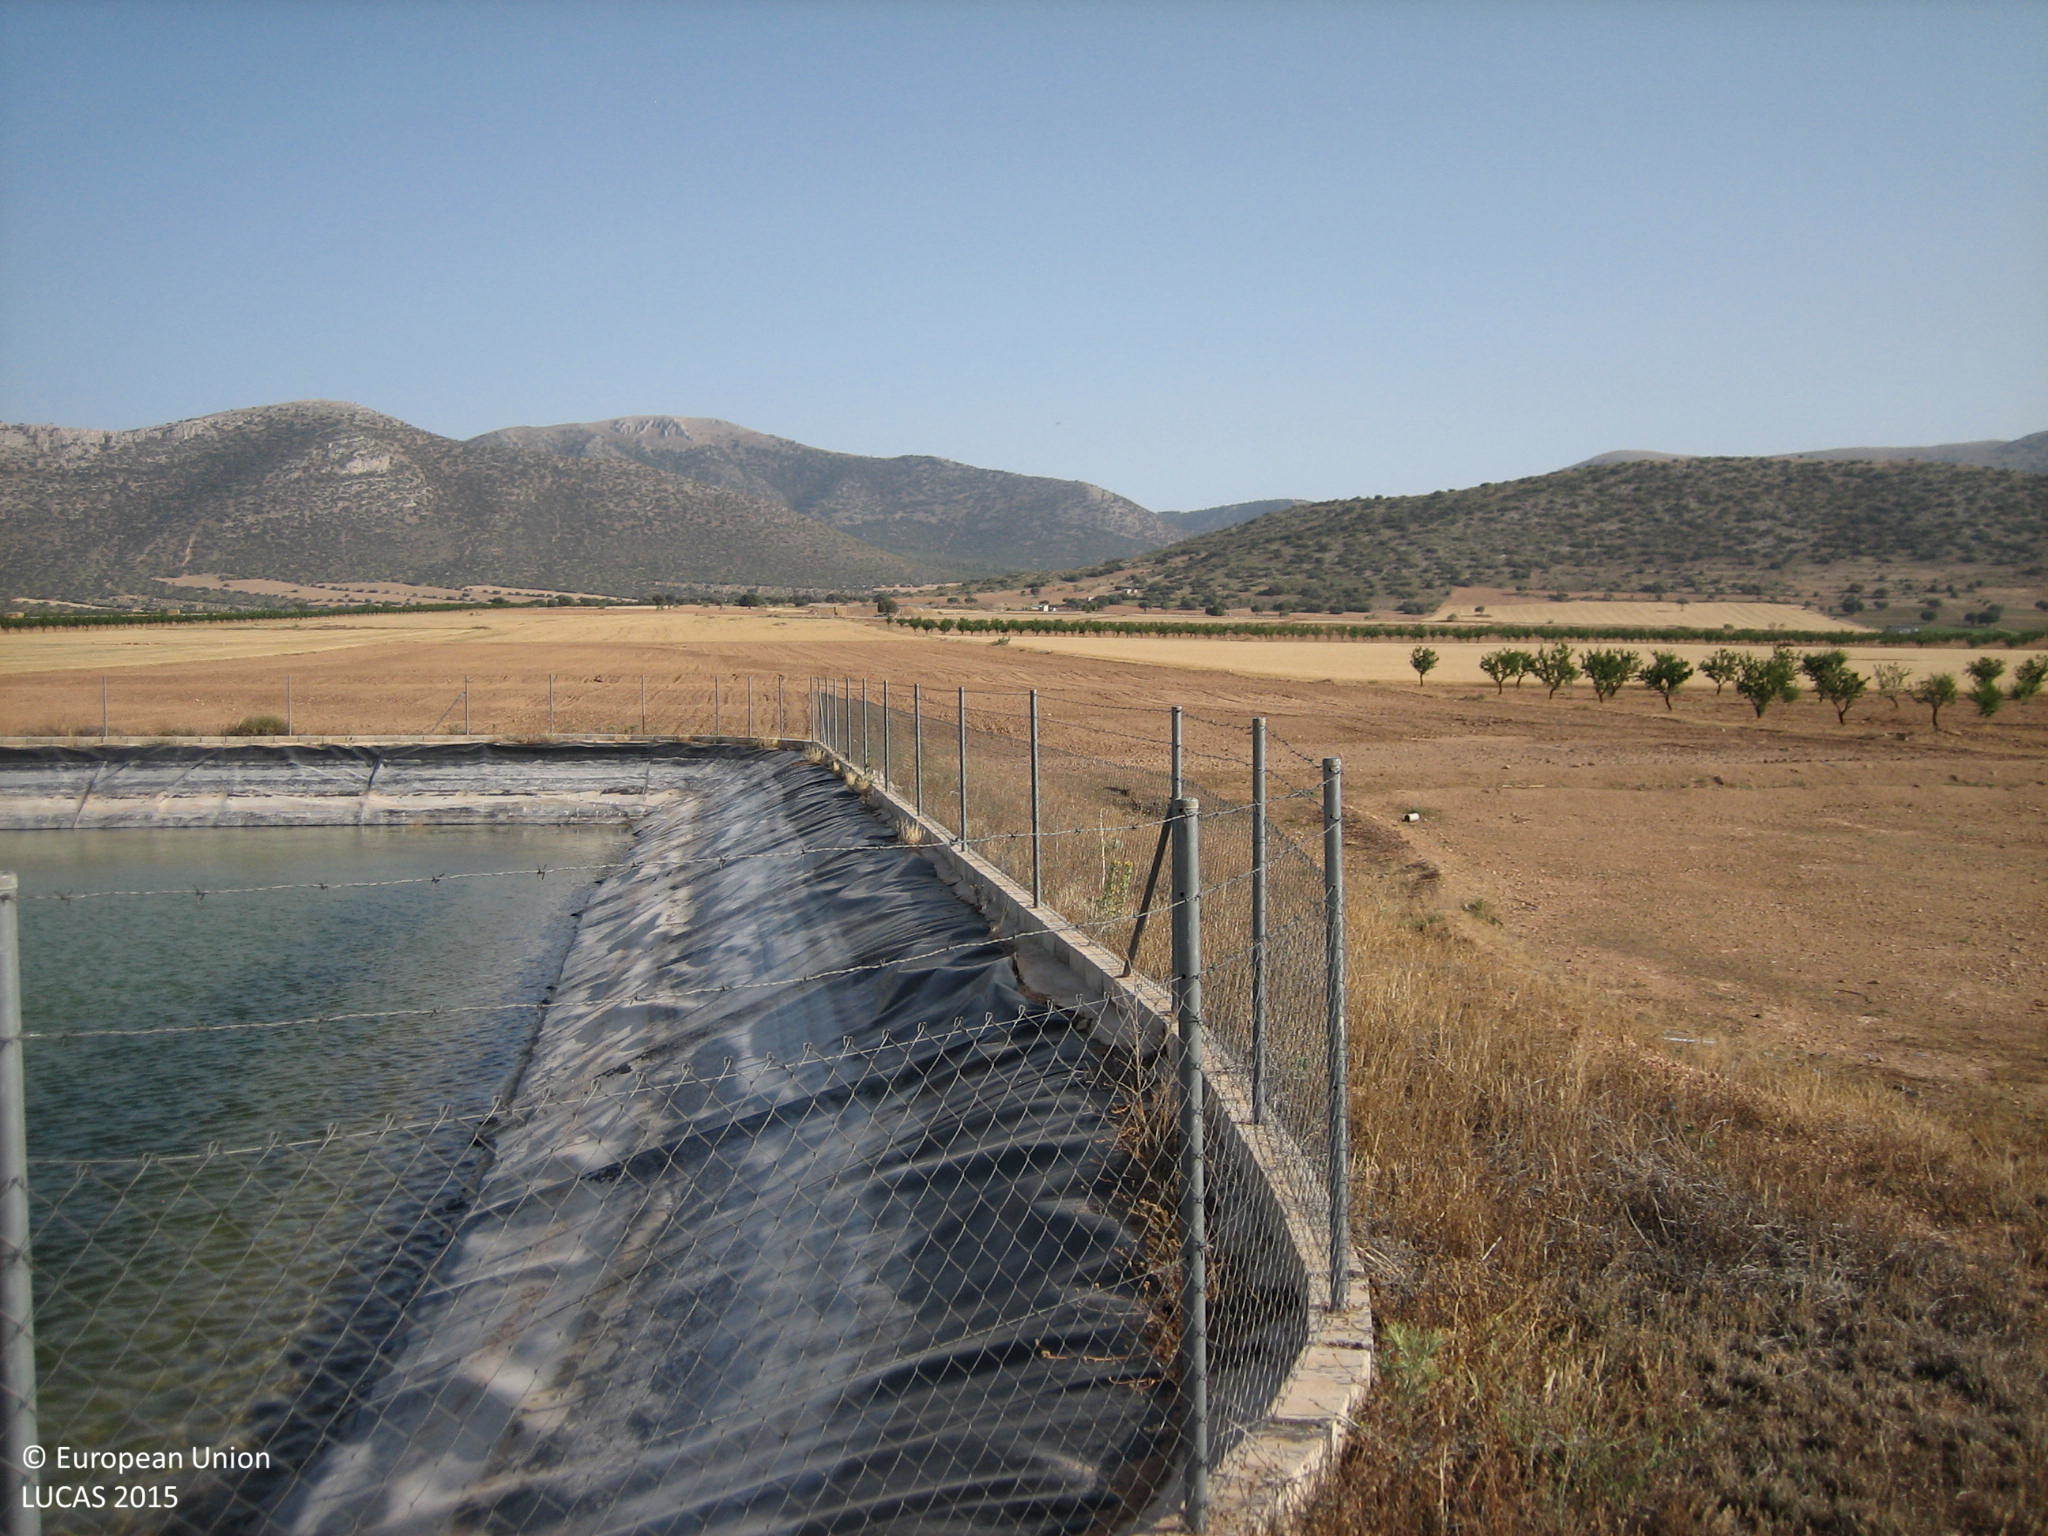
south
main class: Grassland
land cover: Grassland without tree/shrub cover
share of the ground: 50 - 75 %
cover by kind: herbaceous plants 60 %, unconsolidated bare surface 40 %
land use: Protection infrastructures
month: July
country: ES
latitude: 37.6892
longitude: -2.3591
